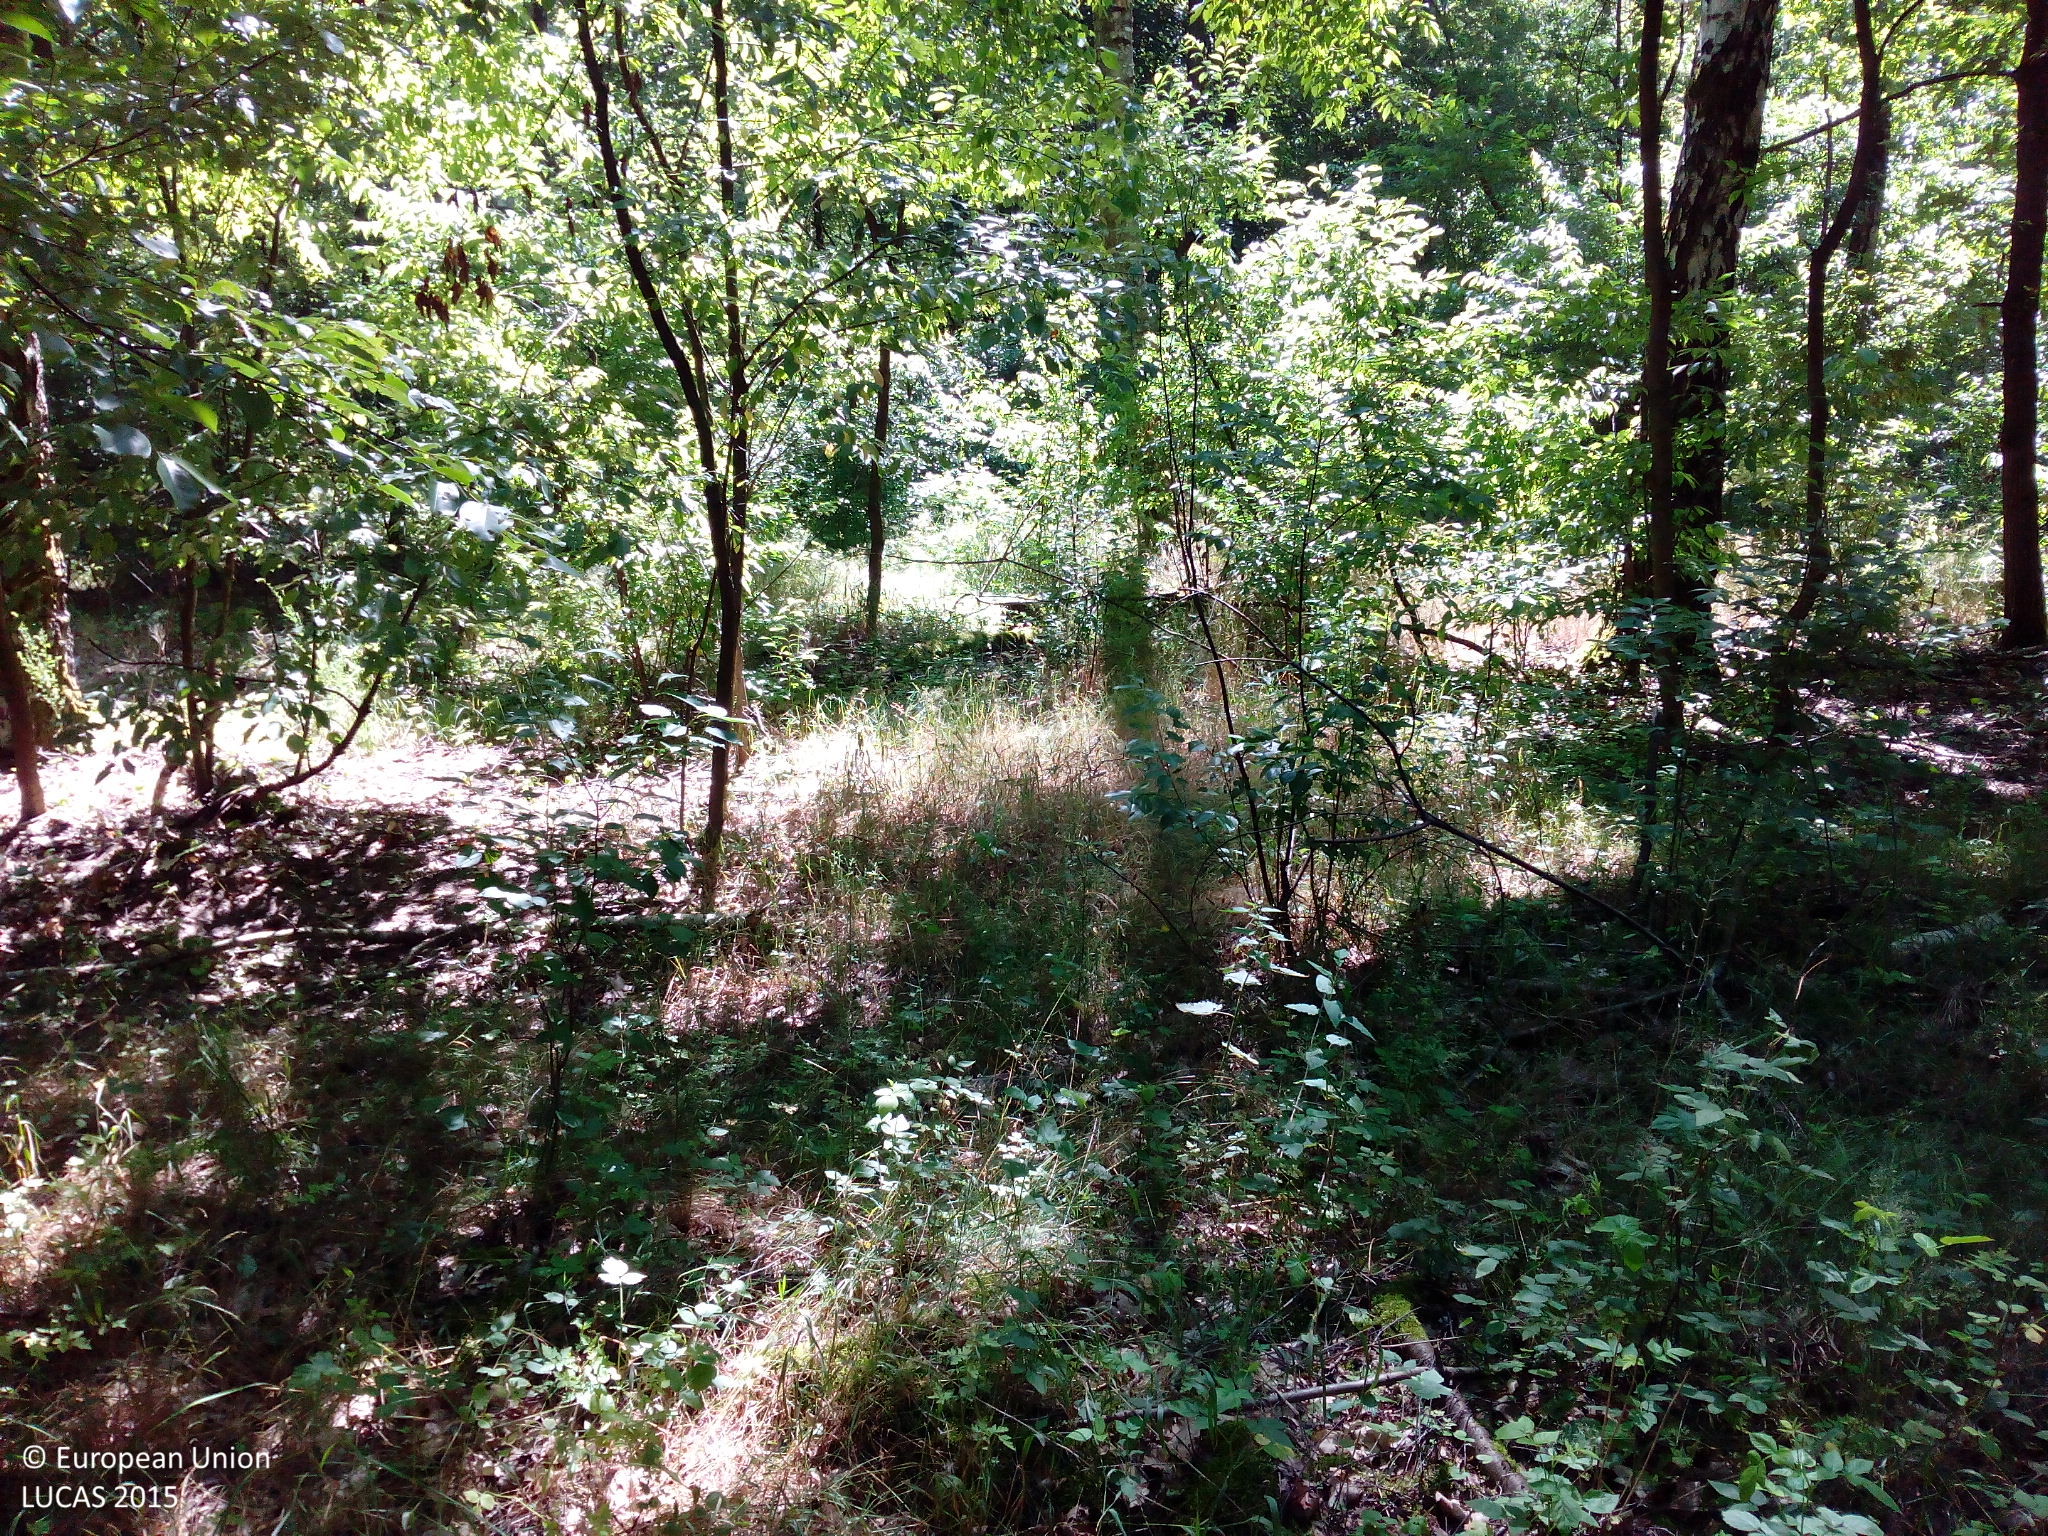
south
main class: Woodland
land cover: Broadleaved woodland
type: mesophytic deciduous forest
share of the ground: > 75 %
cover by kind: broadleaved forest trees 75 %, shrubs 15 %, herbaceous plants 5 %, lichens and mosses 5 %
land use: Forestry
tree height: > 5 m
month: July
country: DE
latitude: 52.6282
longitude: 13.6199
